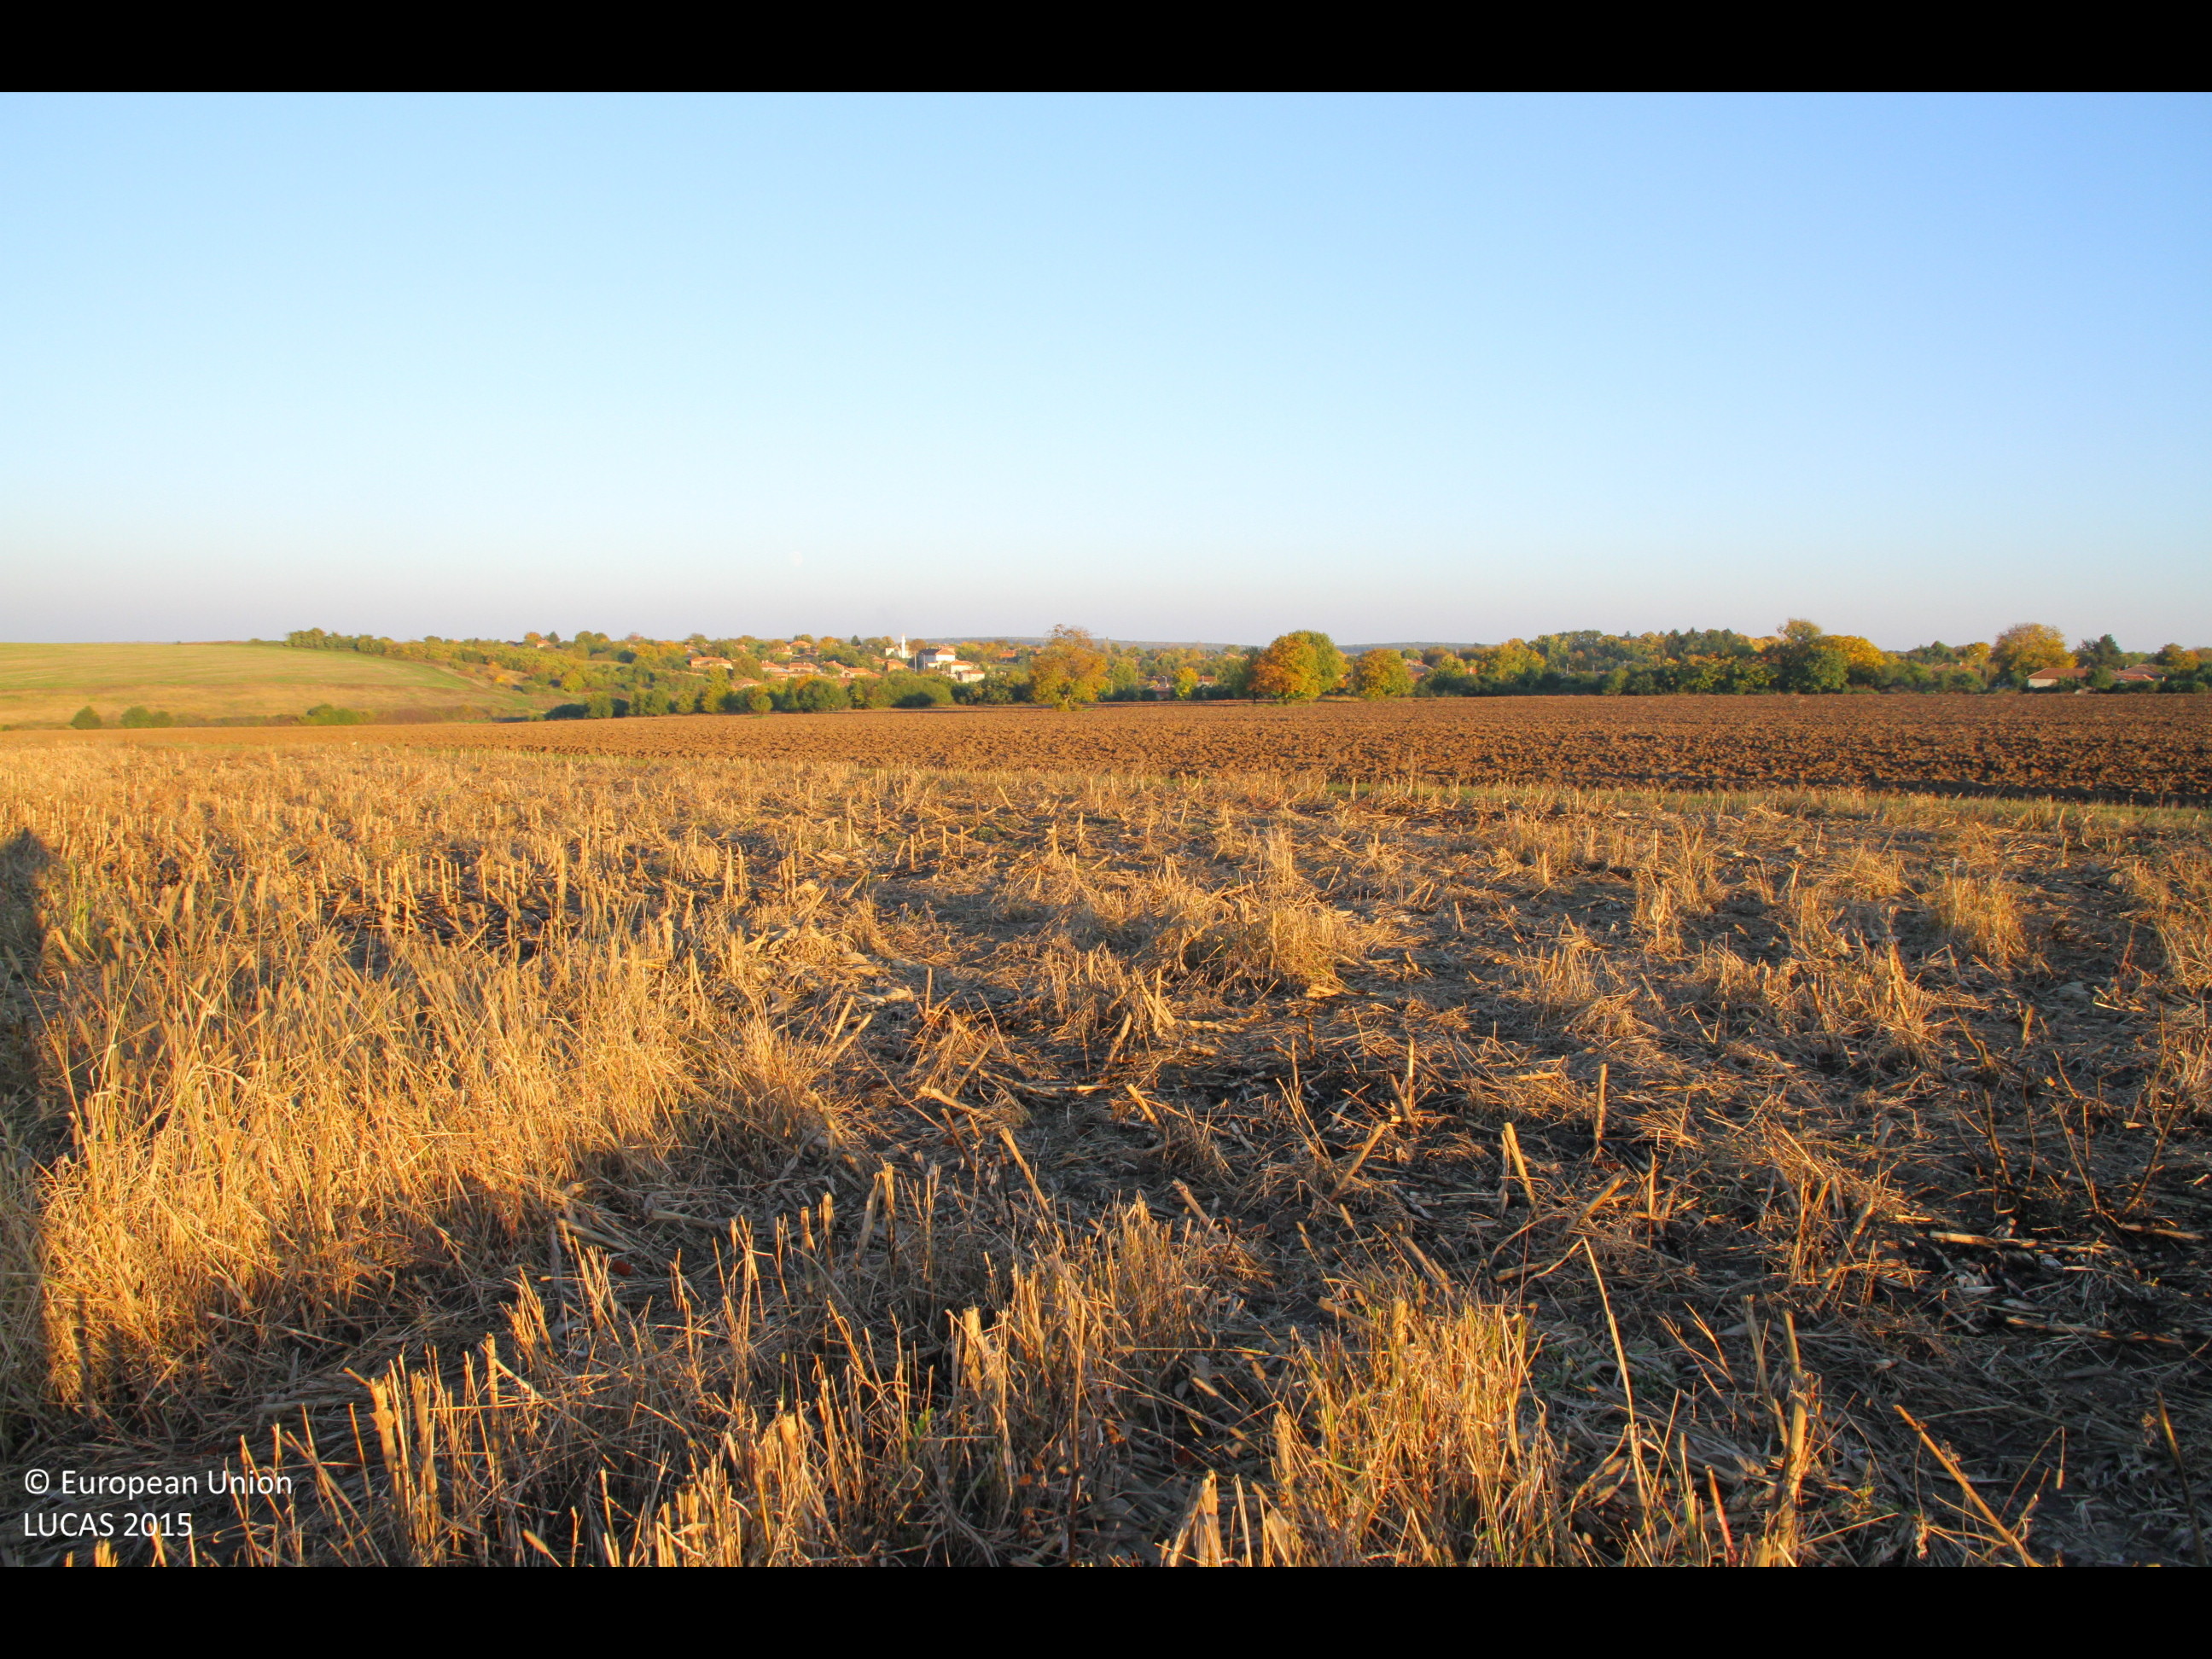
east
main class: Cropland
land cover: Maize
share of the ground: 10 - 25 %
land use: Agriculture (excluding fallow land and kitchen gardens)
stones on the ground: < 10 %
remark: Harvested field
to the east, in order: Maize; Tracks; Maize
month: October
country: BG
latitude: 43.7069
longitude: 26.4496
